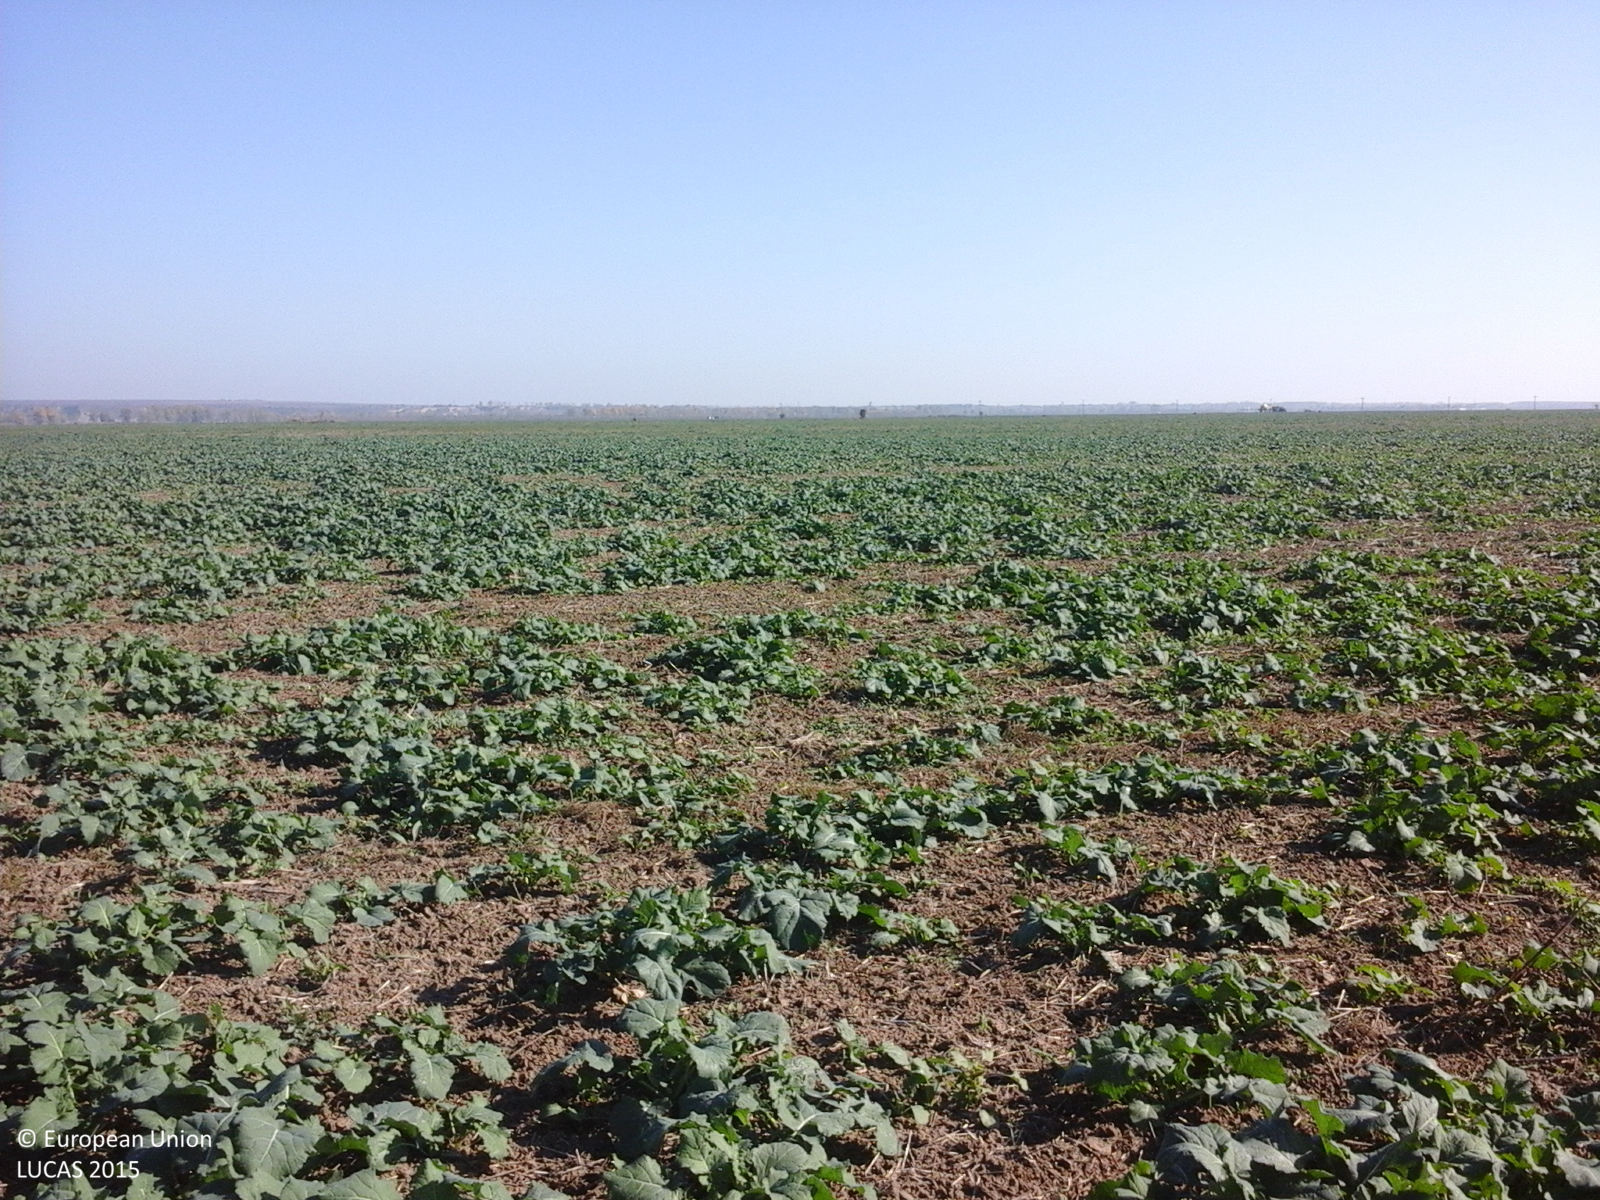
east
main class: Cropland
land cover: Rape and turnip rape
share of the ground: > 75 %
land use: Agriculture (excluding fallow land and kitchen gardens)
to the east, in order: Rape and turnip rape
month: October
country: RO
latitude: 45.8969
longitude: 27.2265
